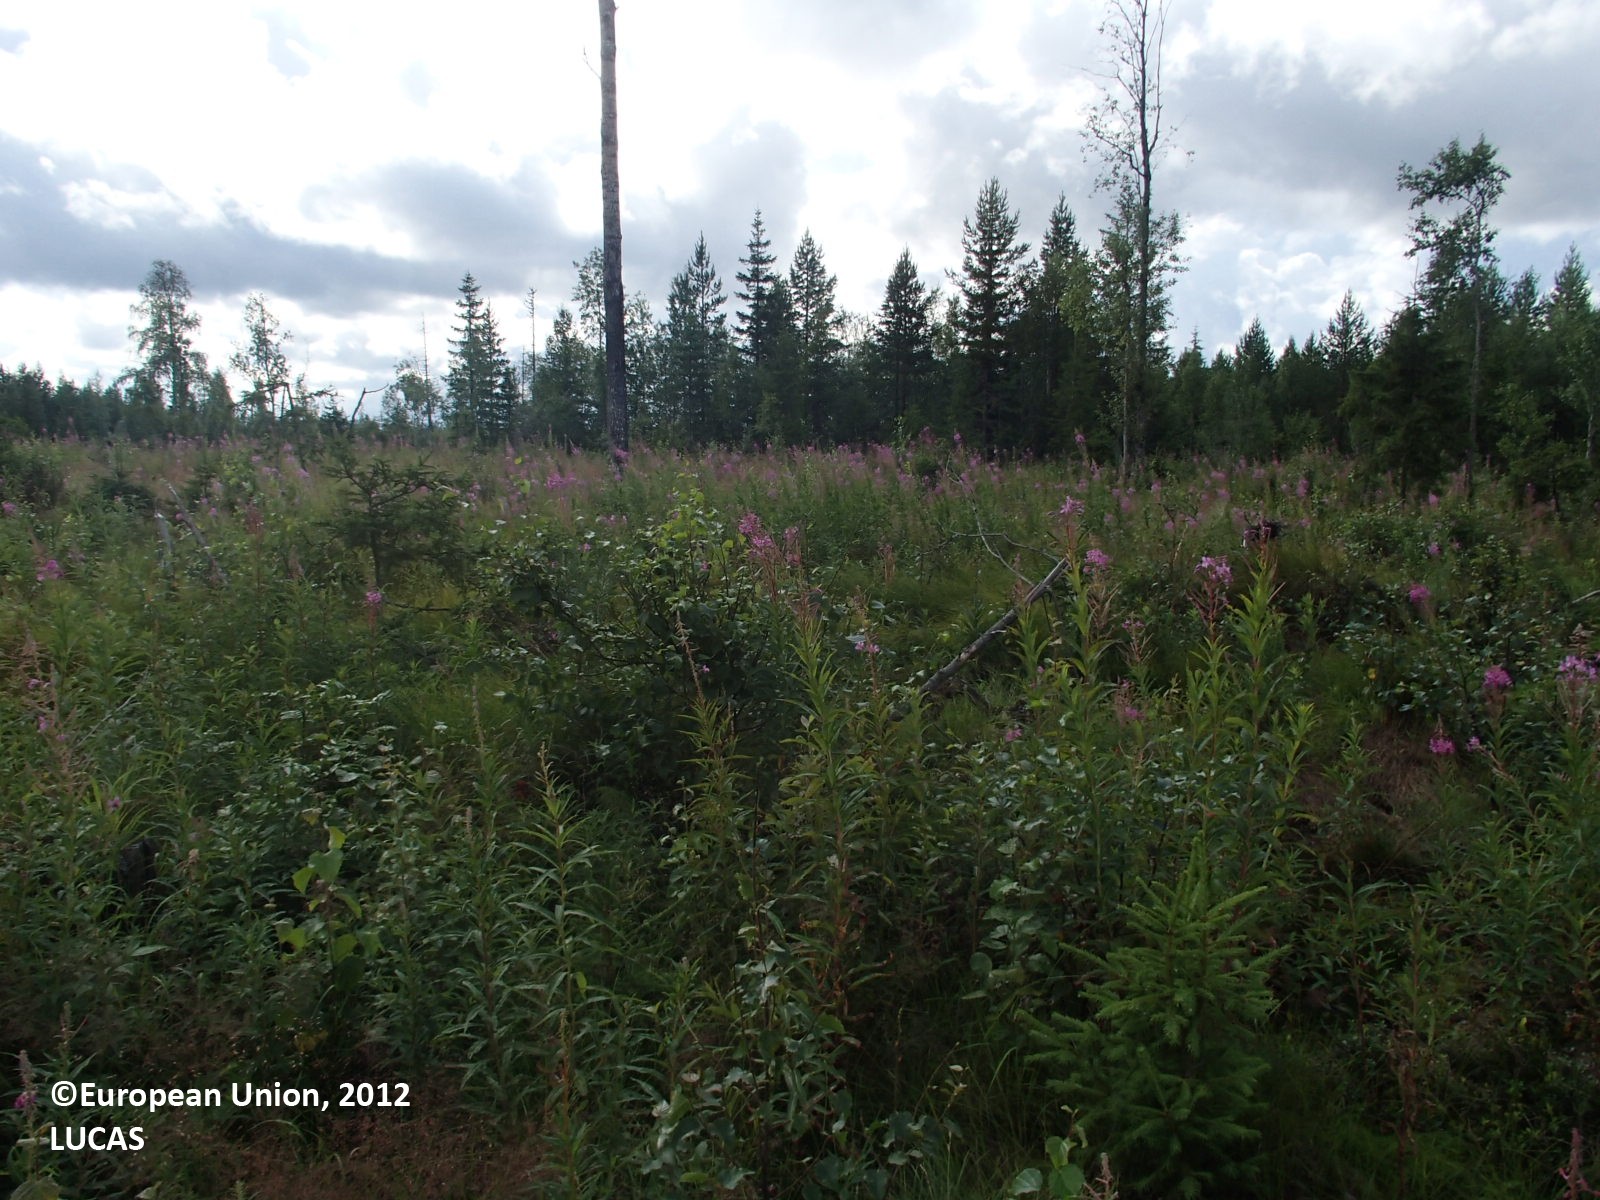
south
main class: Woodland
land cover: Other mixed woodland
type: boreal forest
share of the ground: 25 - 50 %
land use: Forestry
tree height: < 5 m
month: August
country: FI
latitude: 63.9043
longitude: 28.0803
